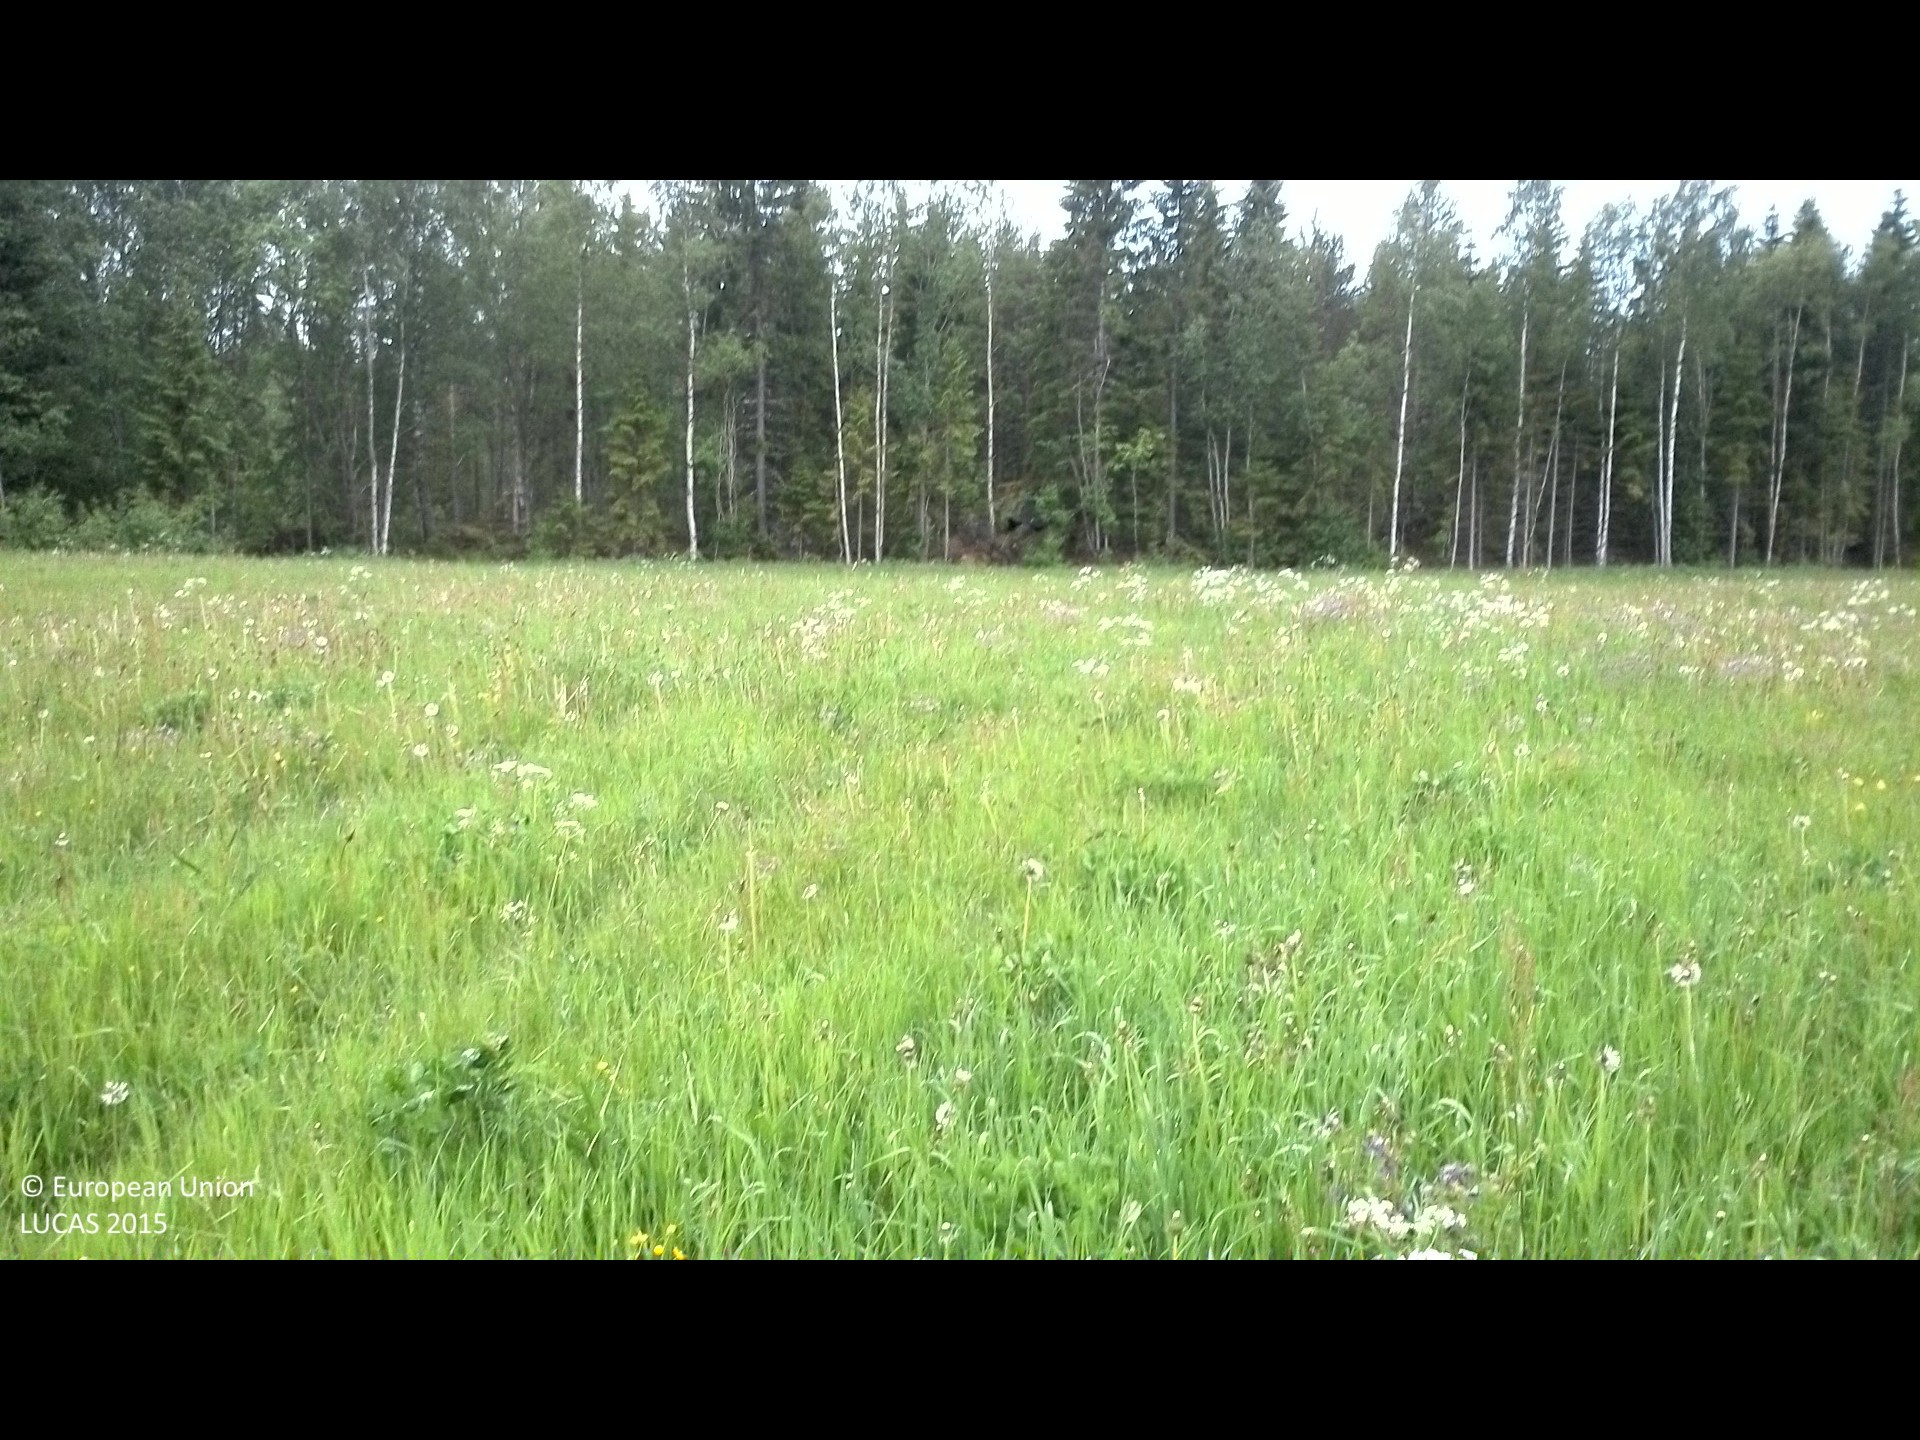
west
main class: Artificial land
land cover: Other artificial areas
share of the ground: > 75 %
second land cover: Other leguminous and mixtures for fodder
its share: > 75 %
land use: Electricity, gas and thermal power distribution
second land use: Agriculture (excluding fallow land and kitchen gardens)
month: June
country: SE
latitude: 62.0189
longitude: 16.9173
